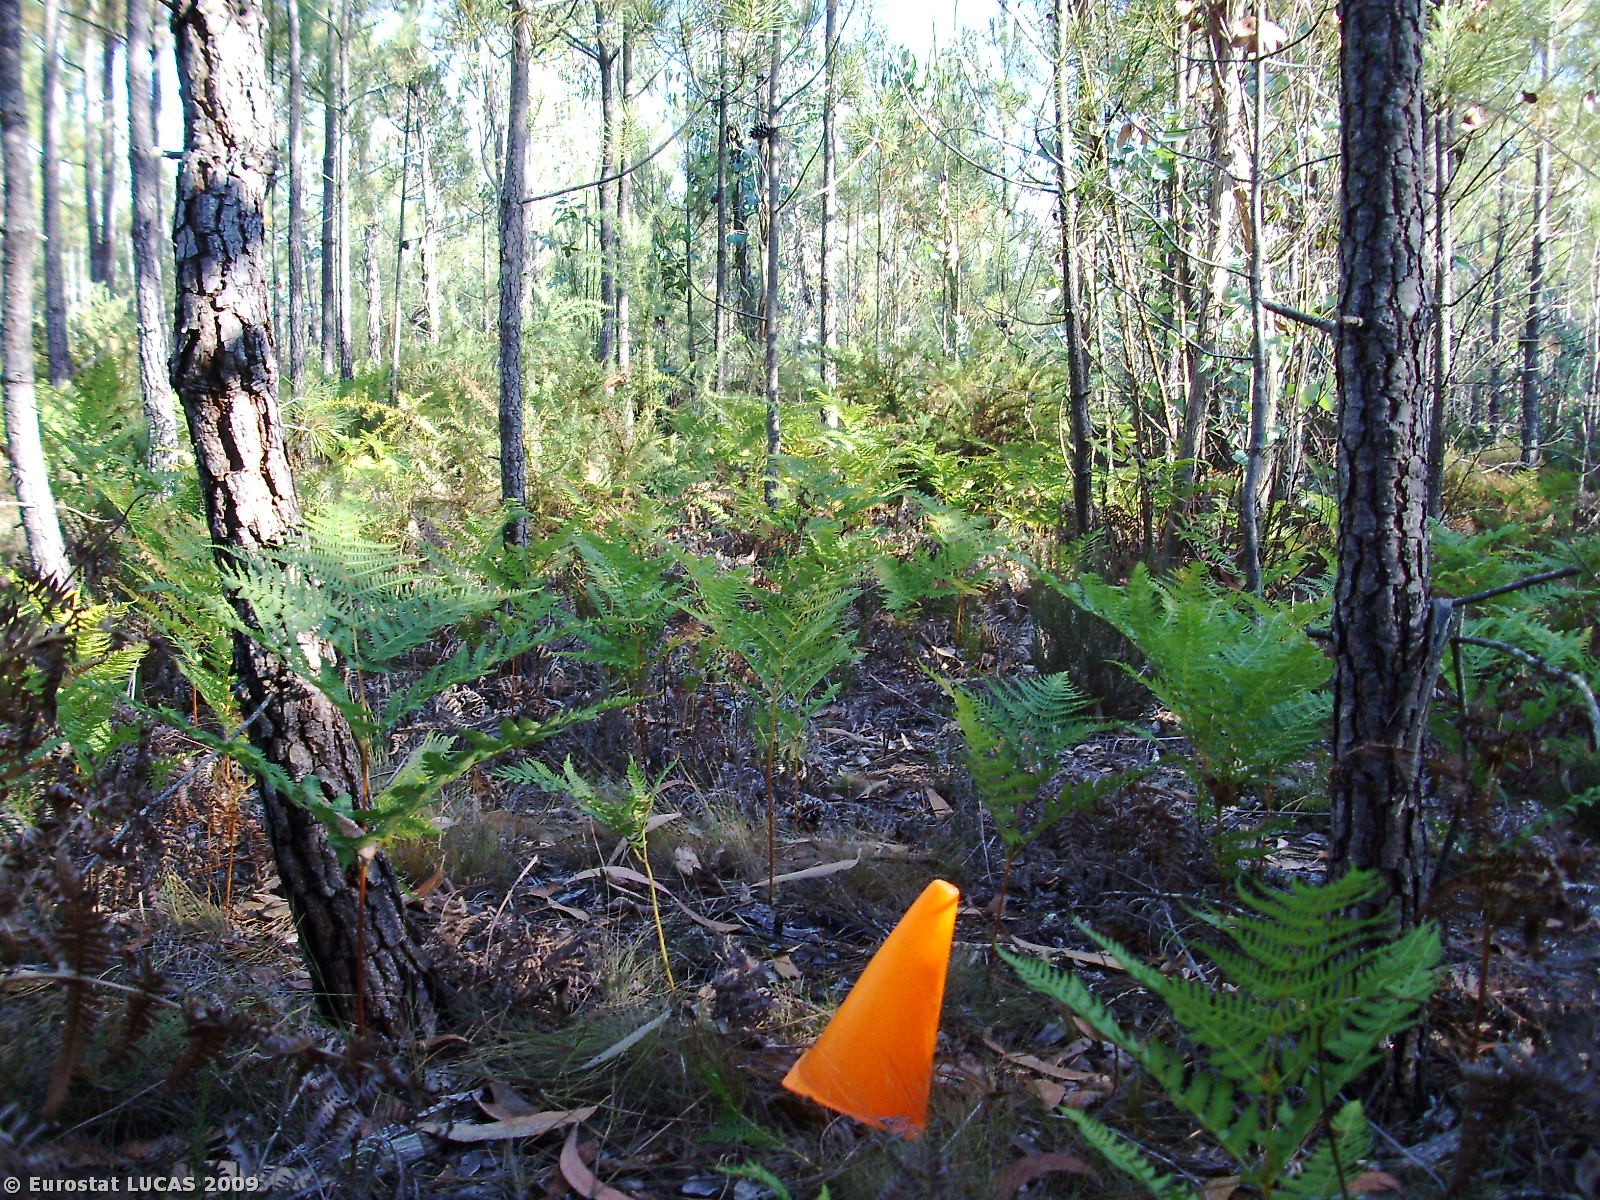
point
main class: Woodland
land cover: Coniferous woodland
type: coniferous forest of the mediterranean region
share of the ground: 50 - 75 %
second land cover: Shrubland with sparse tree cover
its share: 10 - 25 %
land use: Forestry
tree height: > 5 m
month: July
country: PT
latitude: 39.4522
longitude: -9.1606
